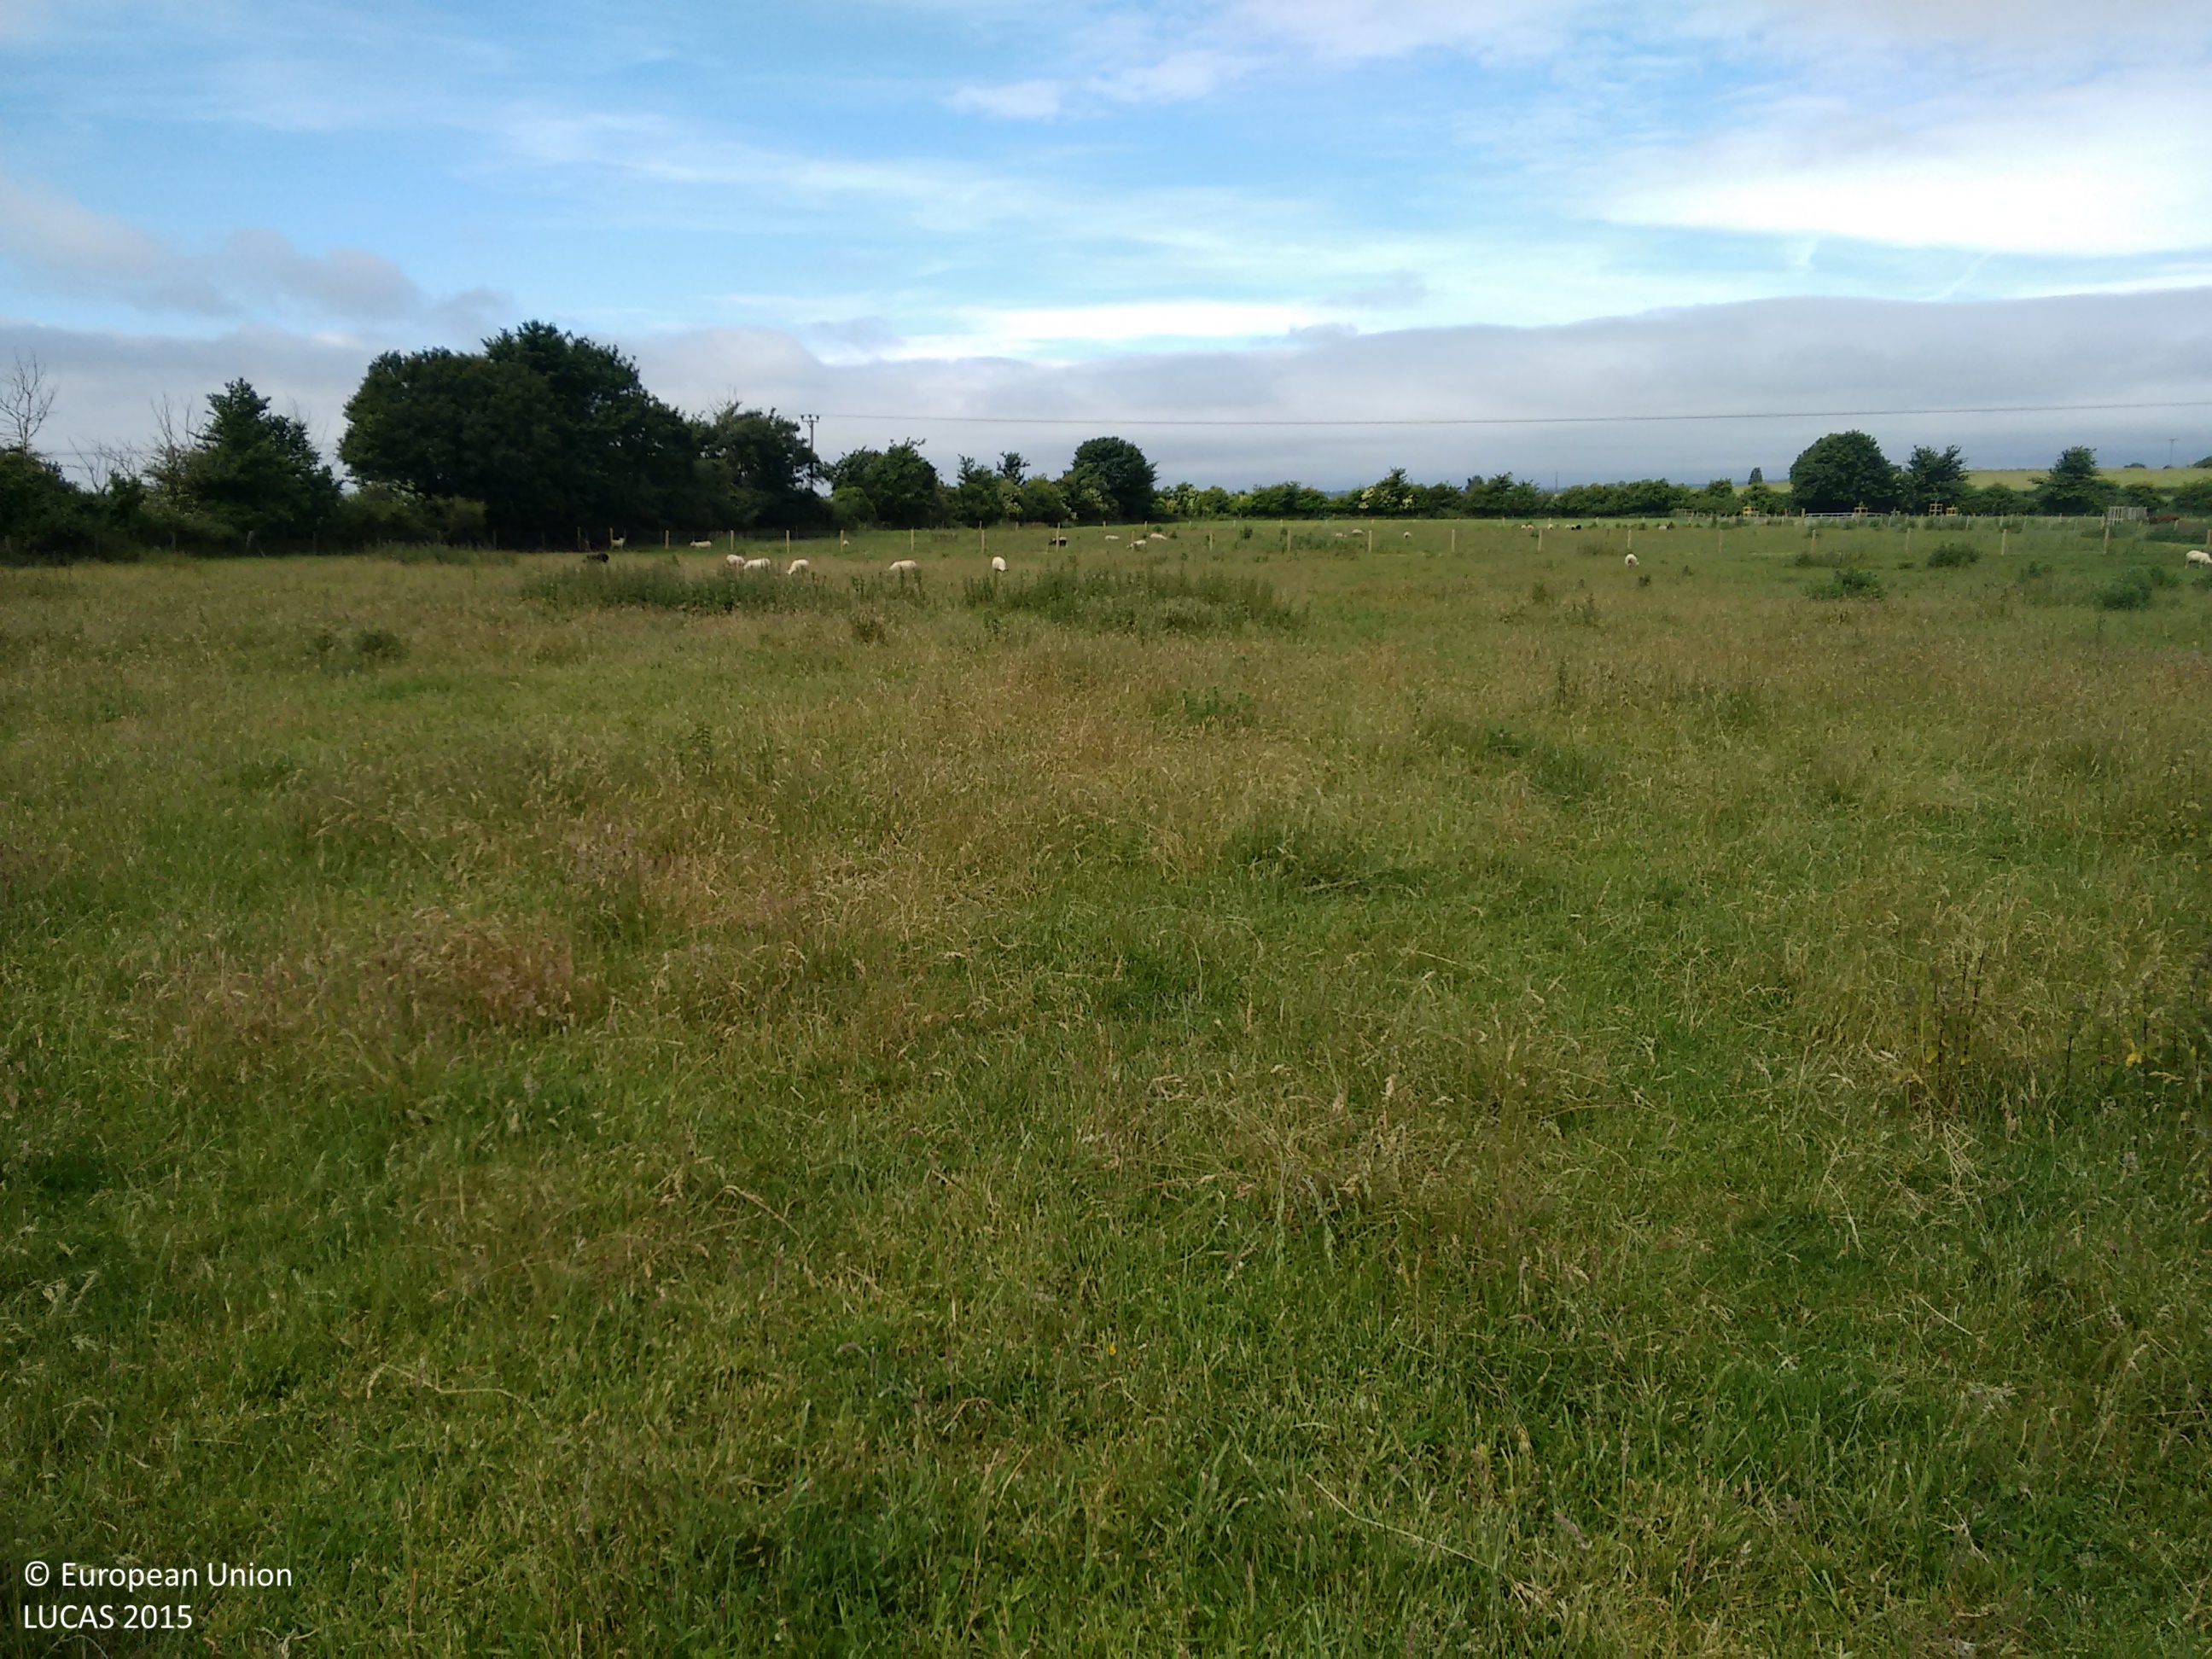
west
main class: Grassland
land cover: Grassland without tree/shrub cover
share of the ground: > 75 %
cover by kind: herbaceous plants 100 %
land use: Agriculture (excluding fallow land and kitchen gardens)
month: June
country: GB
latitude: 51.3488
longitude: -2.1648
